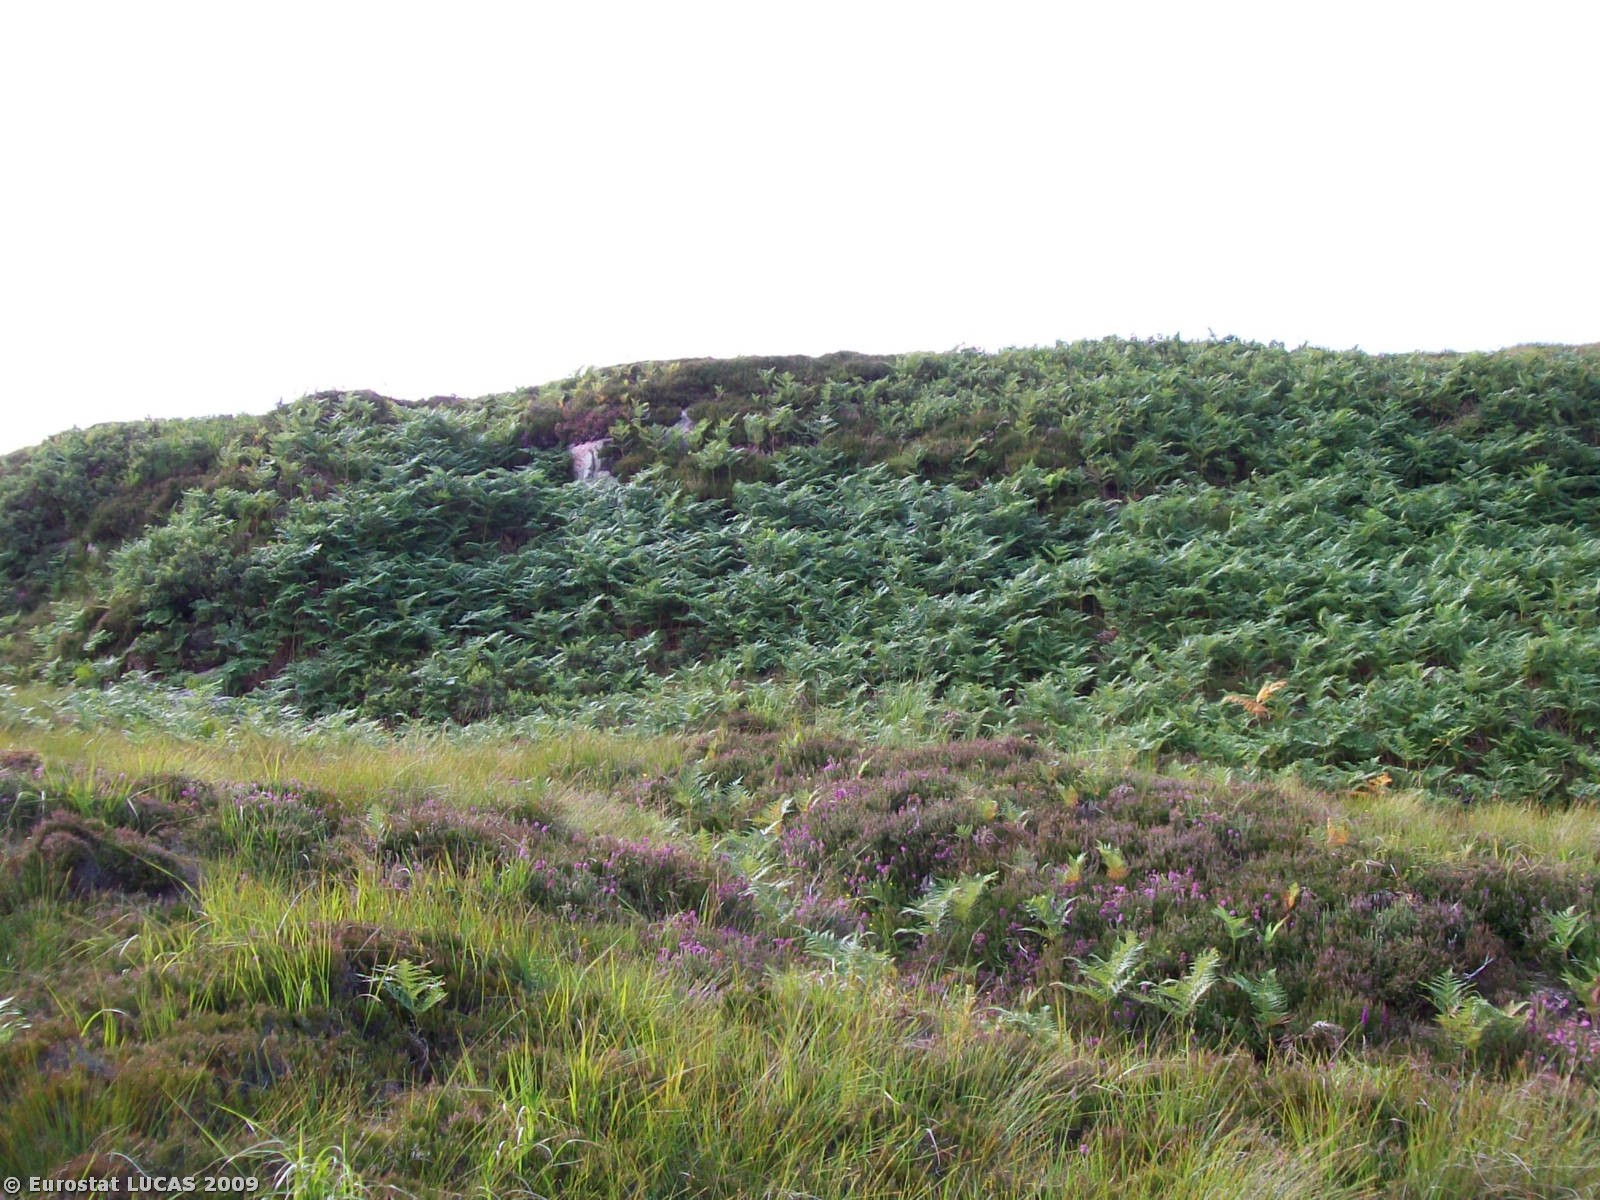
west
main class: Shrubland
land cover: Shrubland without tree cover
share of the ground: > 75 %
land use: Unused
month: July
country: GB
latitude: 58.5444
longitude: -4.6752
